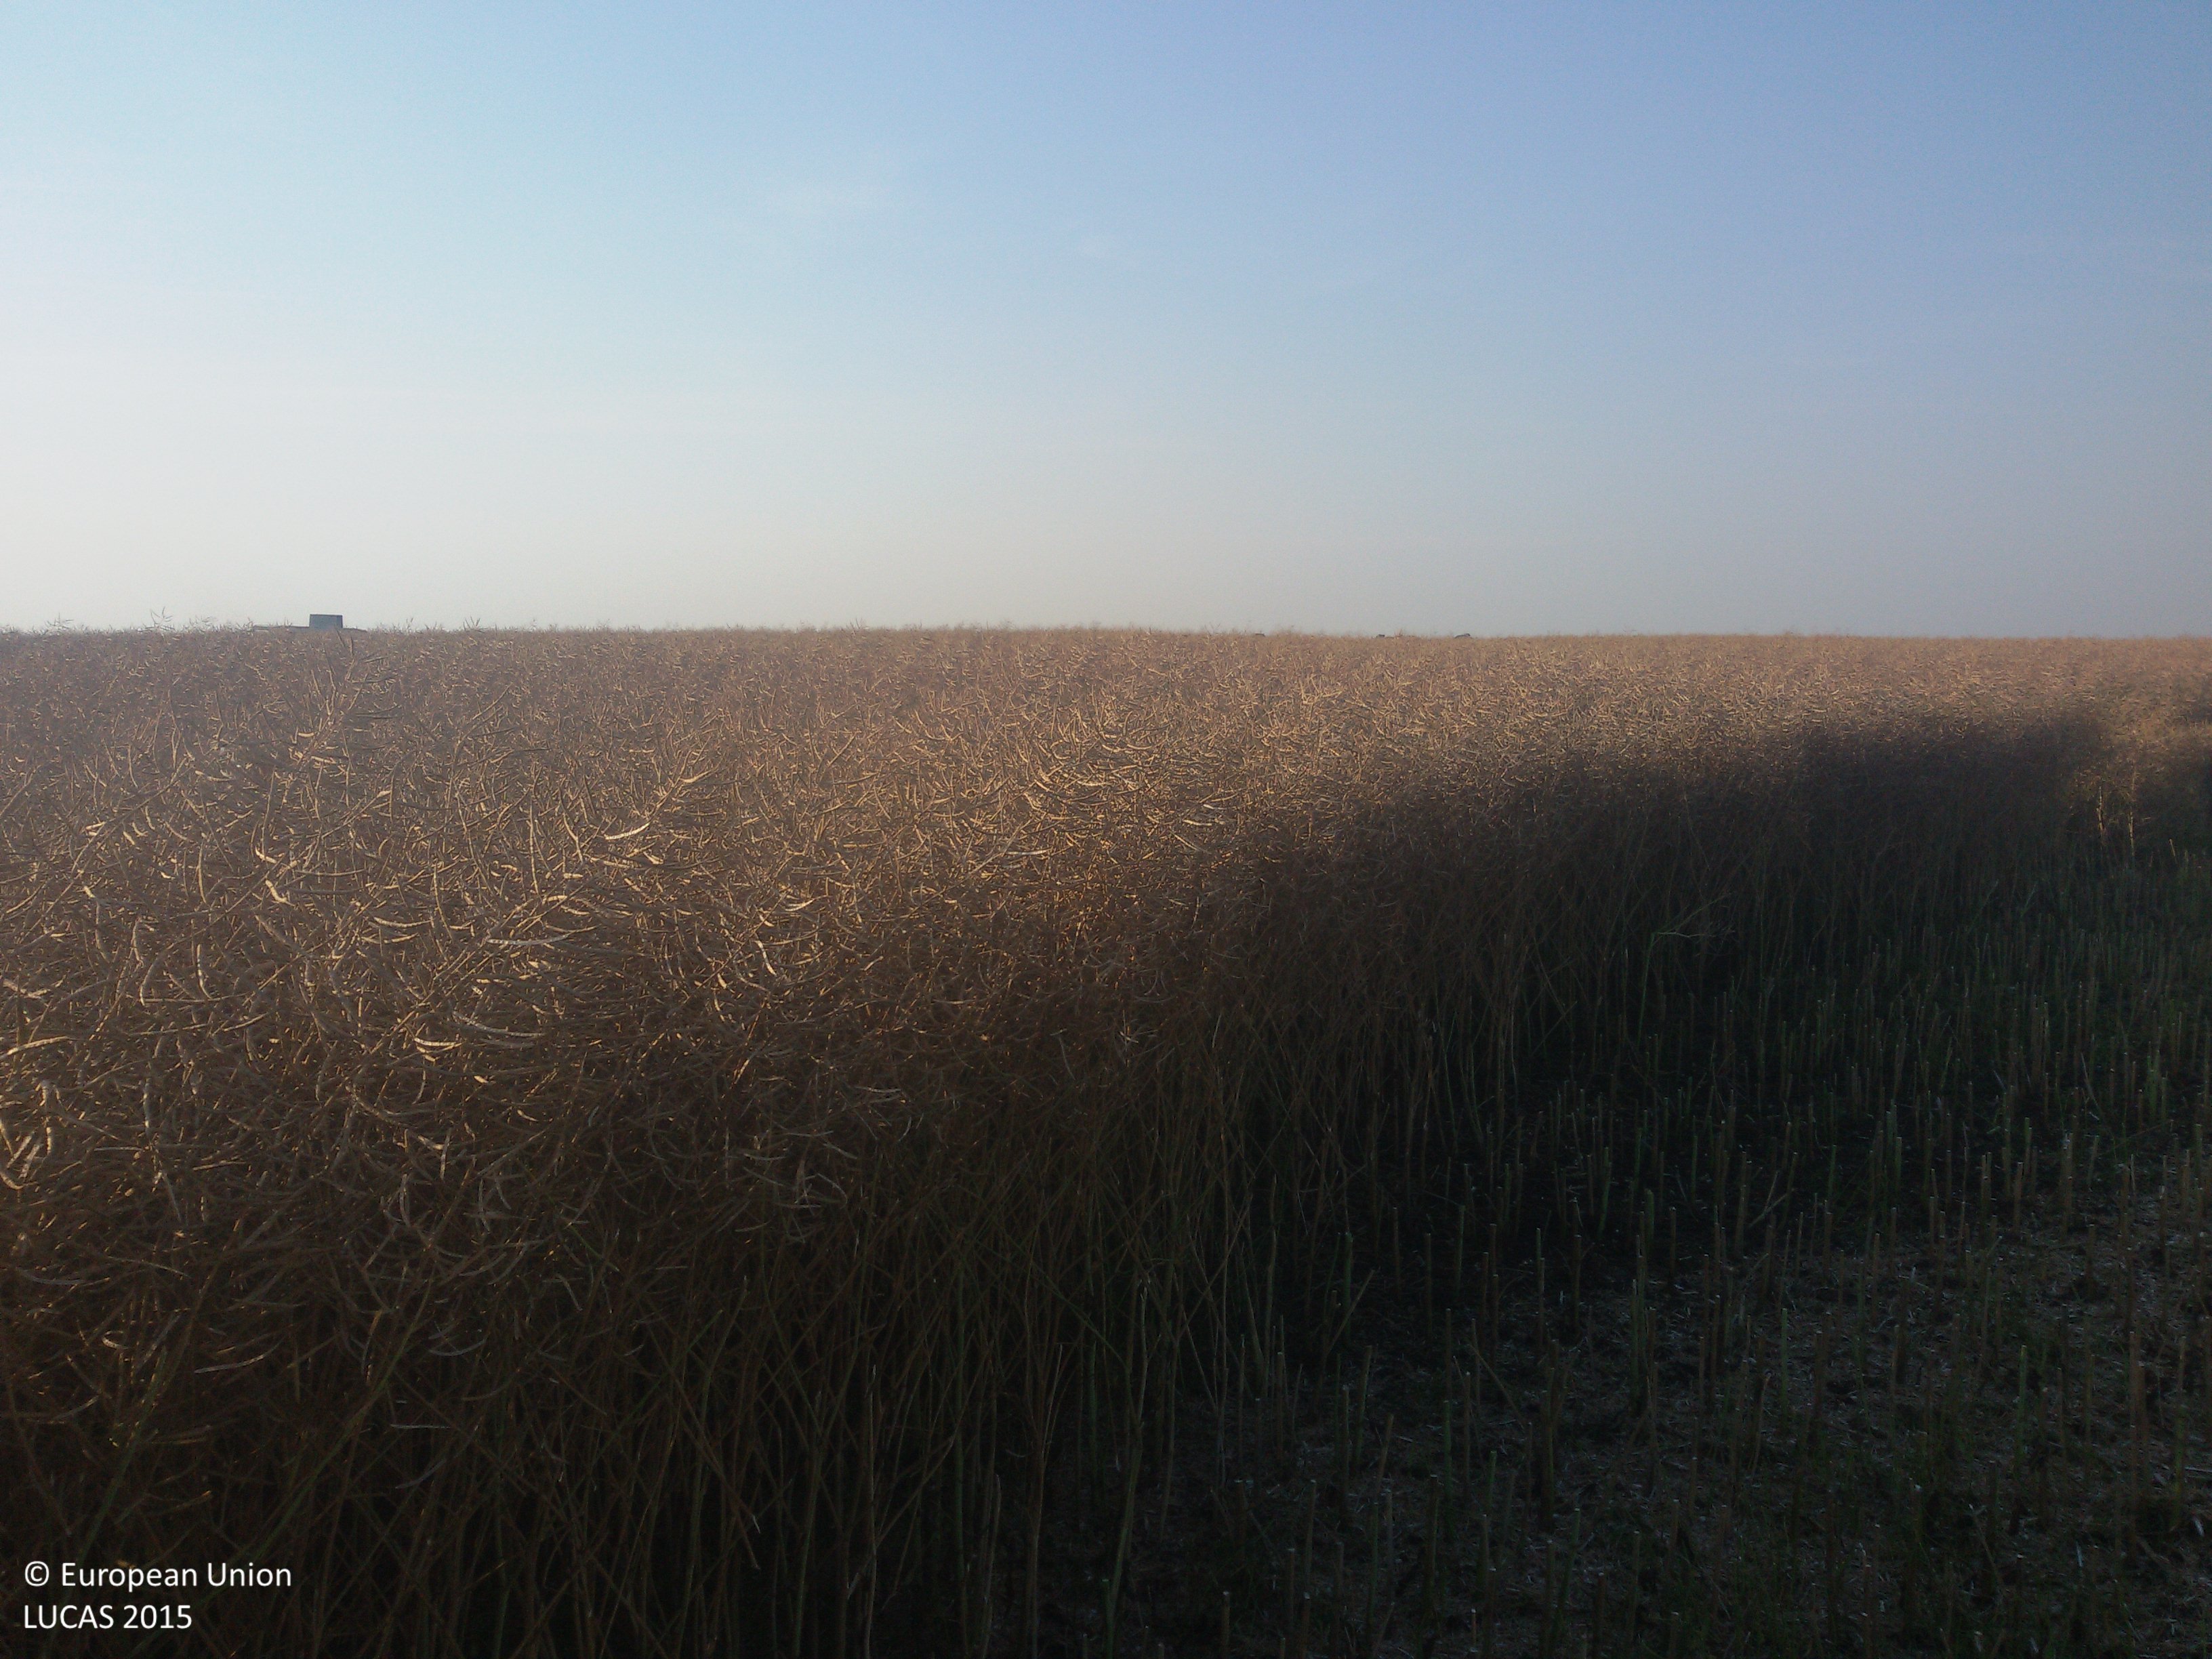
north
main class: Cropland
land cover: Rape and turnip rape
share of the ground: > 75 %
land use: Agriculture (excluding fallow land and kitchen gardens)
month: August
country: PL
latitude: 54.1511
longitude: 21.2069
